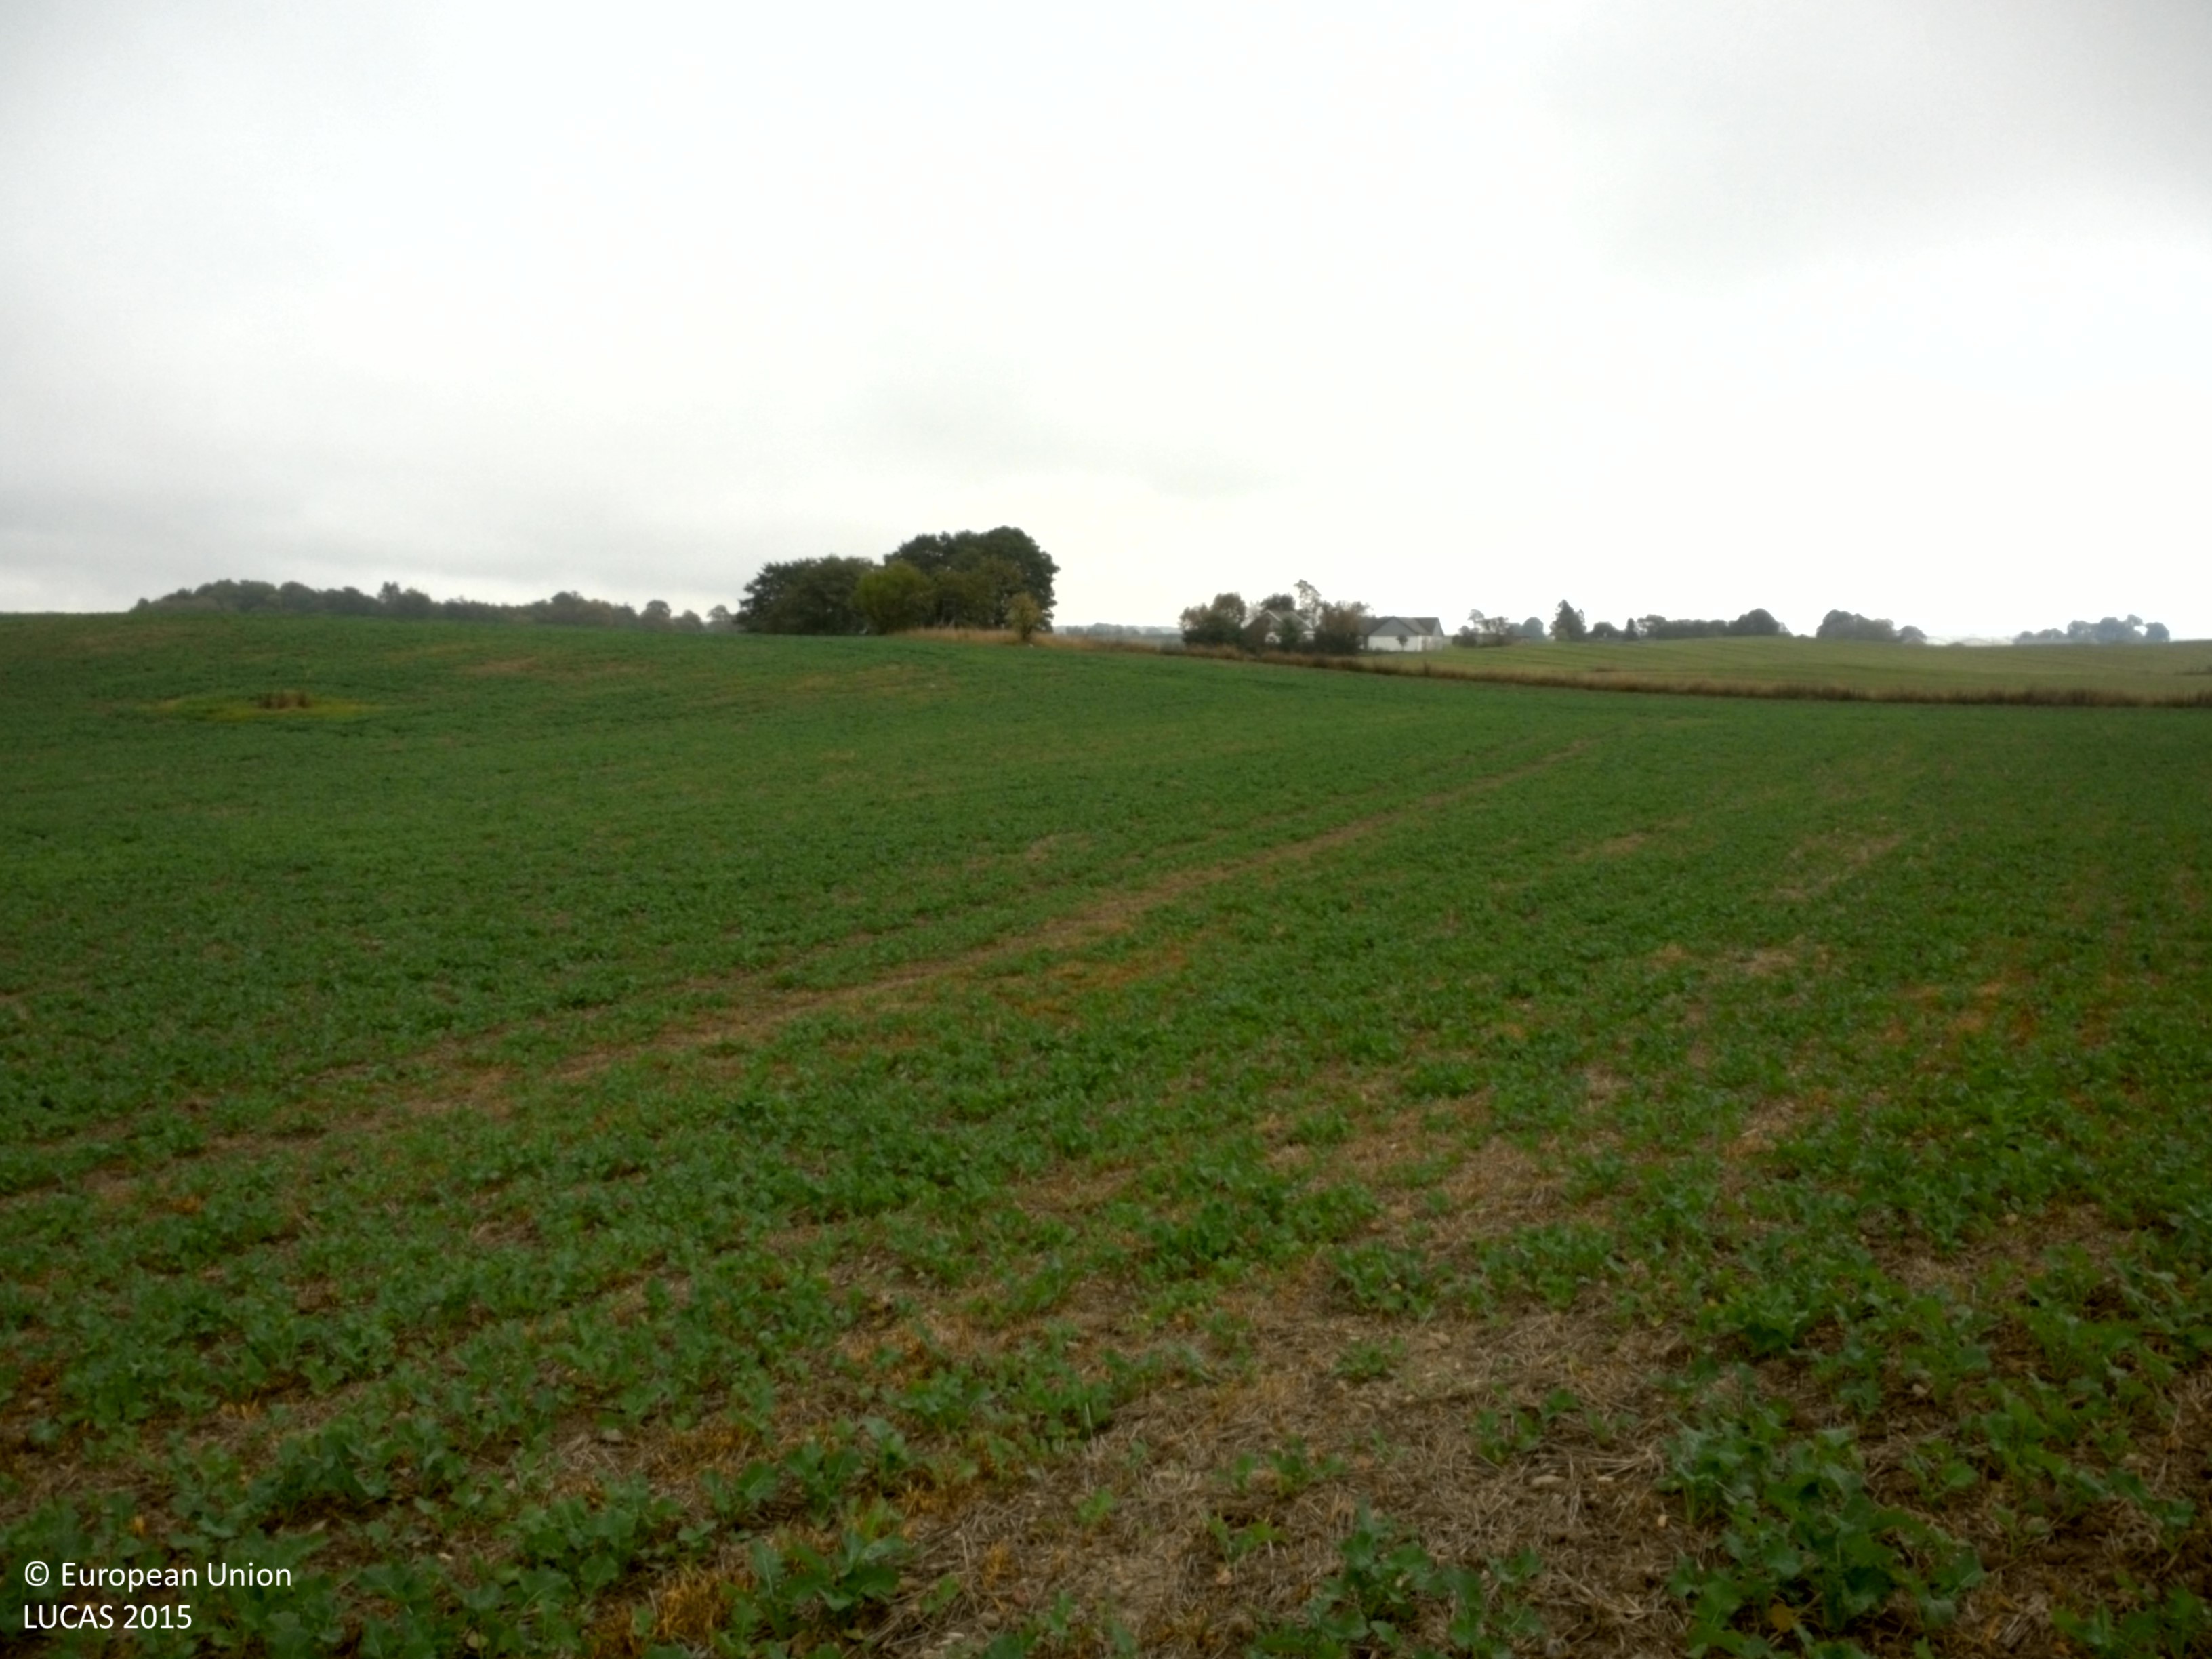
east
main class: Cropland
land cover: Rape and turnip rape
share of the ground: 50 - 75 %
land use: Agriculture (excluding fallow land and kitchen gardens)
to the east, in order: Rape and turnip rape; Grass margins; Ditches and canals; Grass margins; Grassland without tree/shrub cover
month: October
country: SE
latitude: 55.6399
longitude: 13.9860
